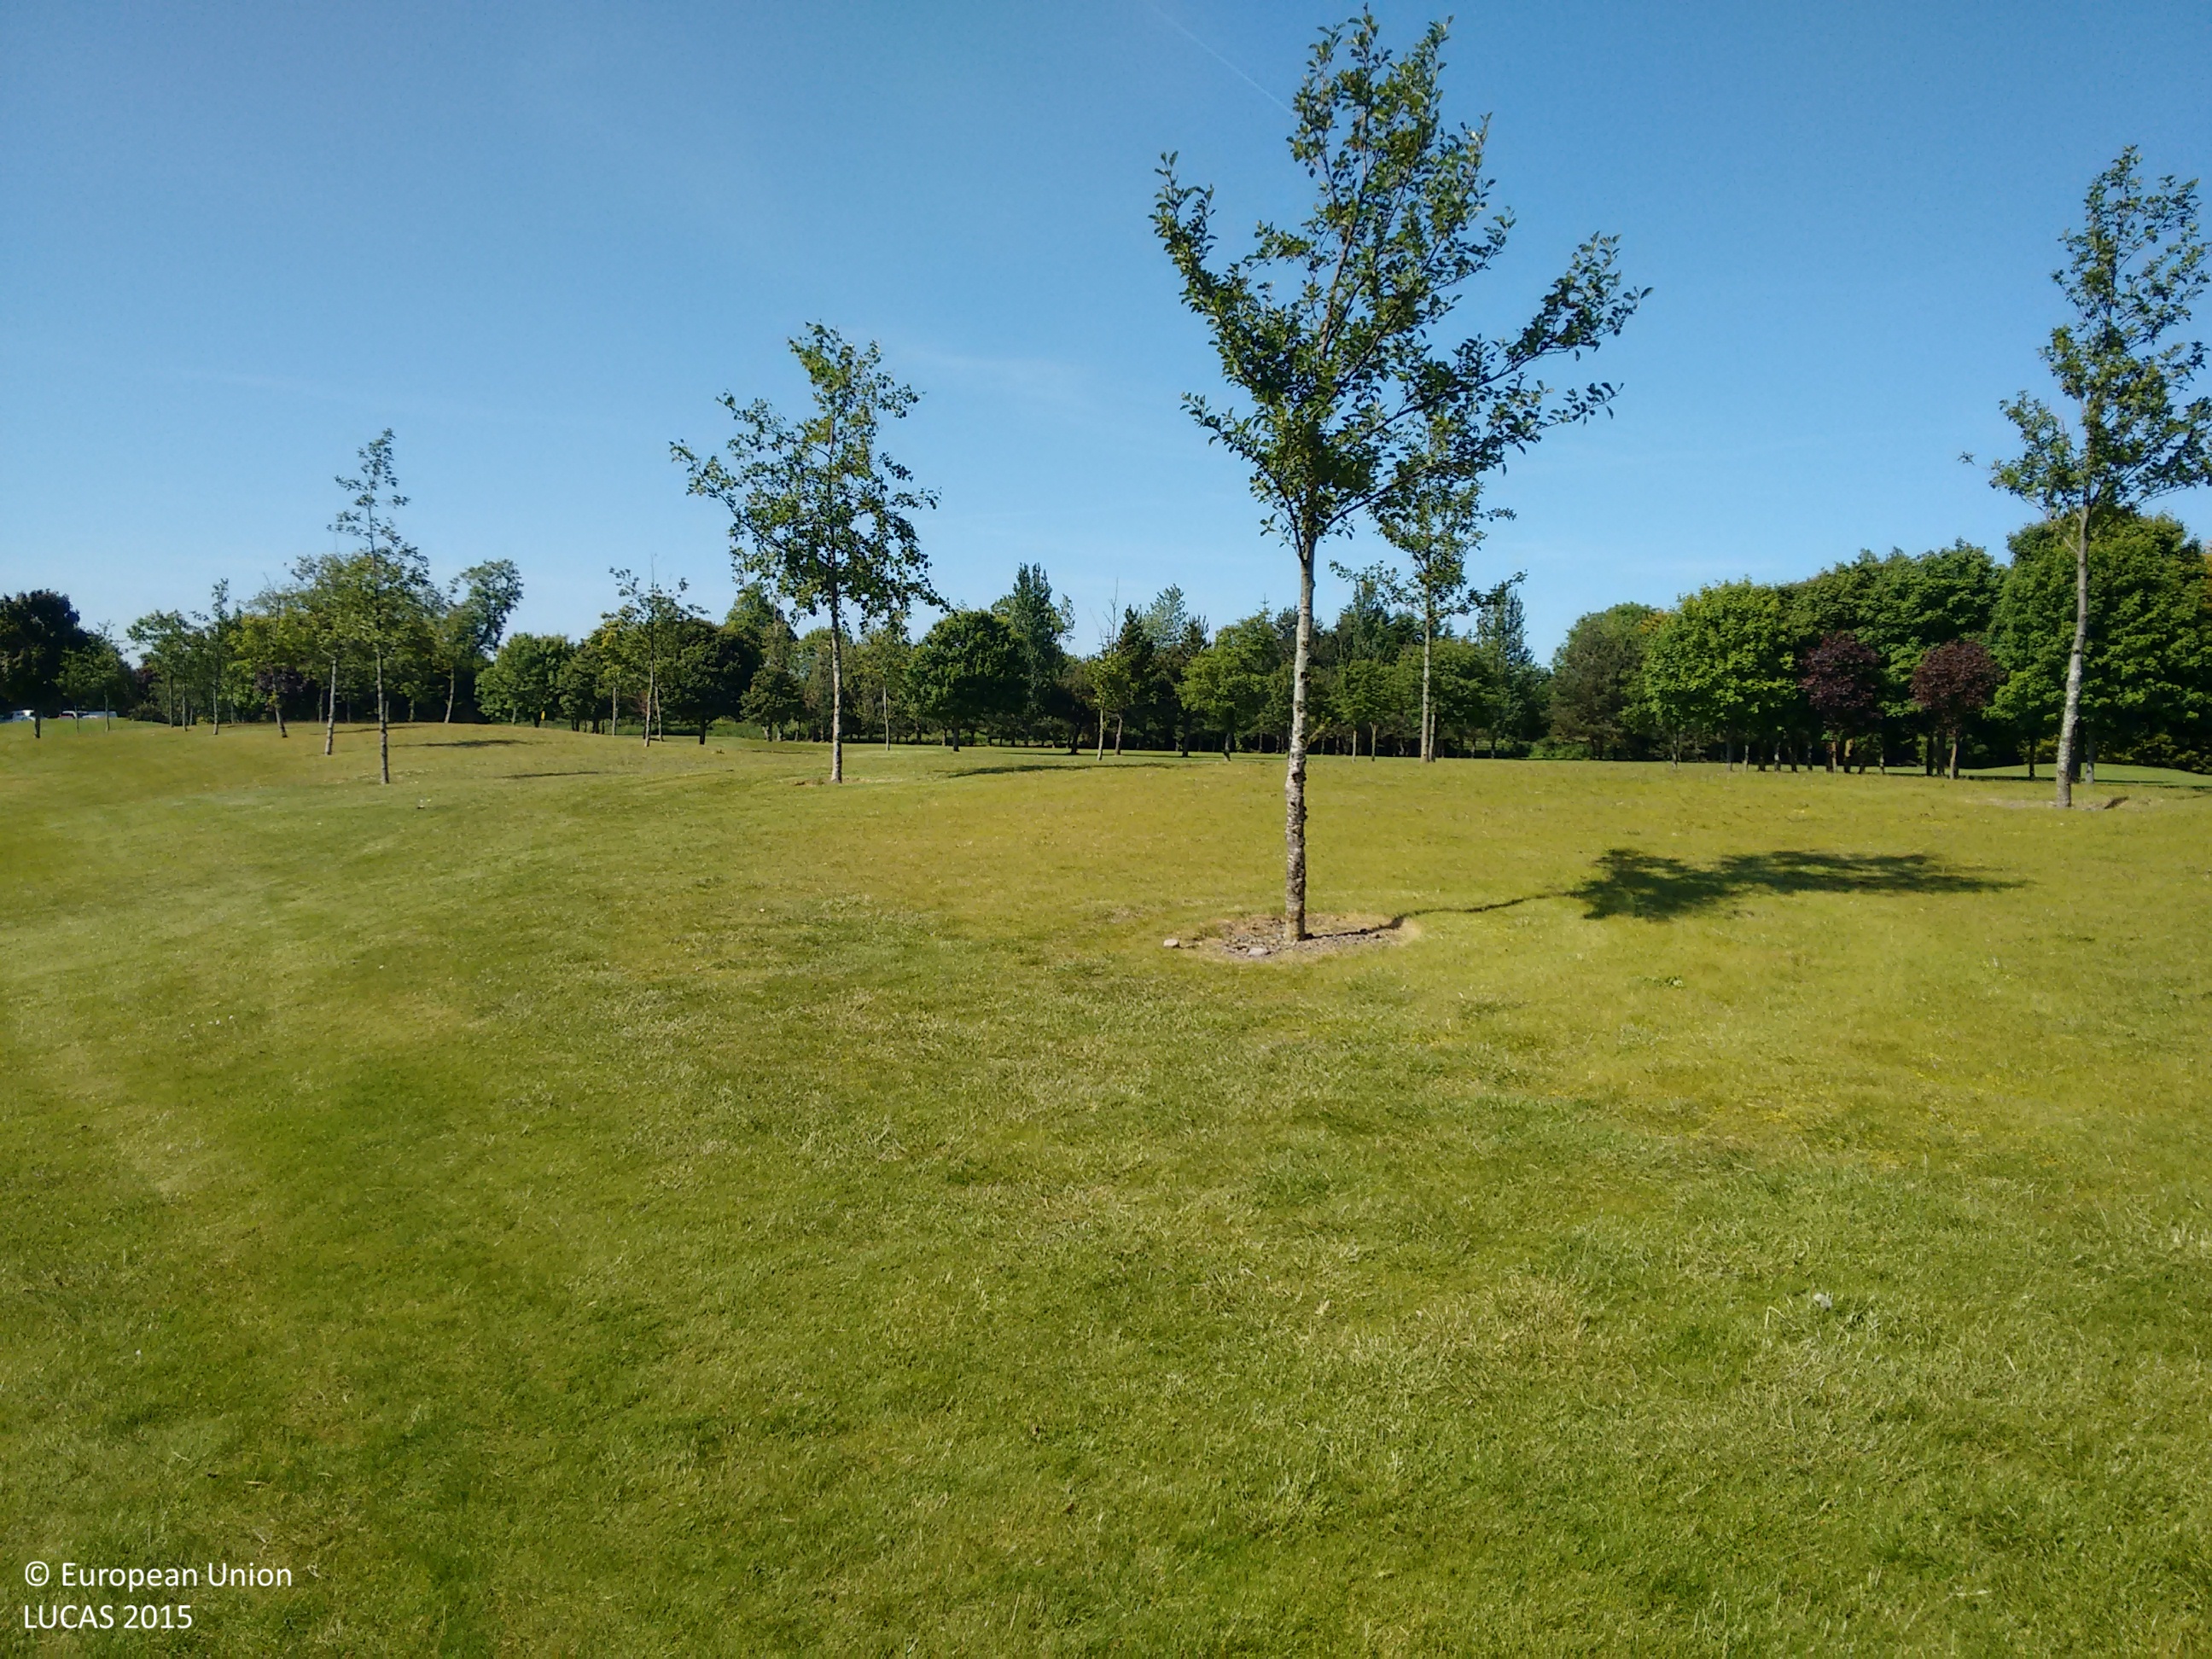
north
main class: Grassland
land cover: Grassland with sparse tree/shrub cover
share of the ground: > 75 %
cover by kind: herbaceous plants 90 %, broadleaved forest trees 5 %, shrubs 5 %
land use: Sport
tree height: < 5 m
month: June
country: IE
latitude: 53.4860
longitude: -6.2602
